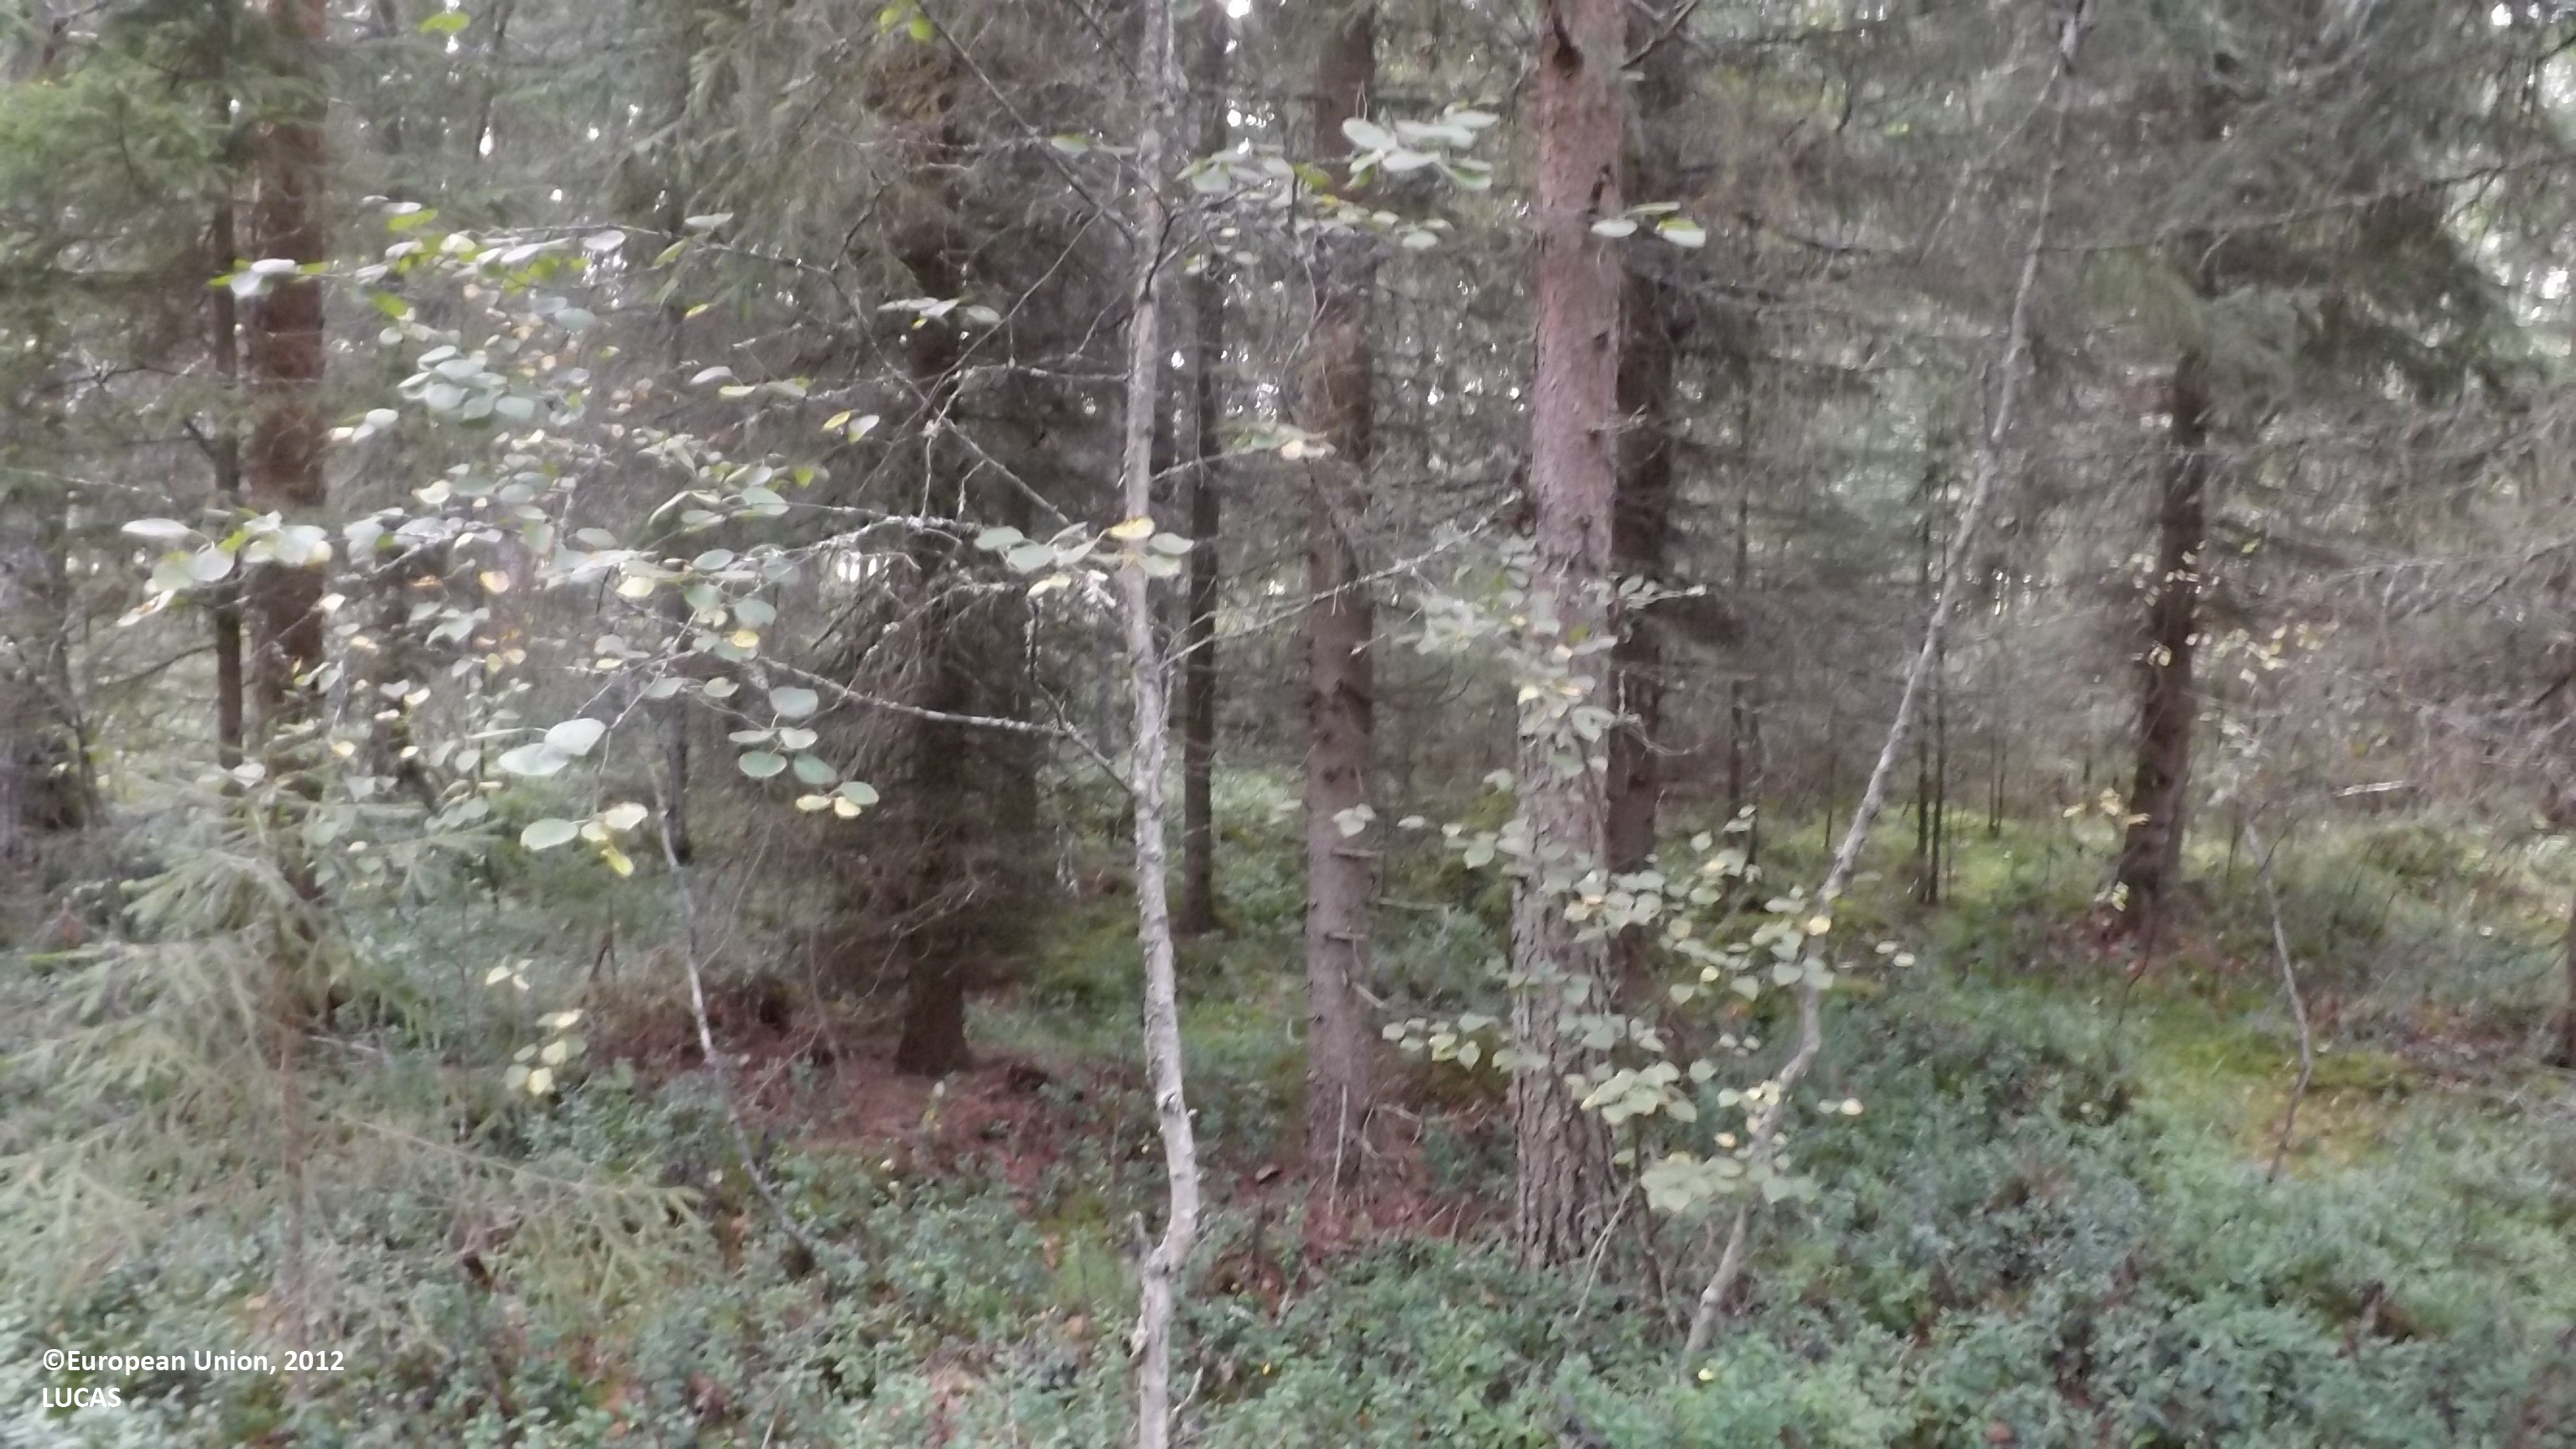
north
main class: Woodland
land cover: Pine dominated mixed woodland
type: boreal forest
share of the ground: 50 - 75 %
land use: Forestry
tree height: > 5 m
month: August
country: FI
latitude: 63.8227
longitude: 23.4470
